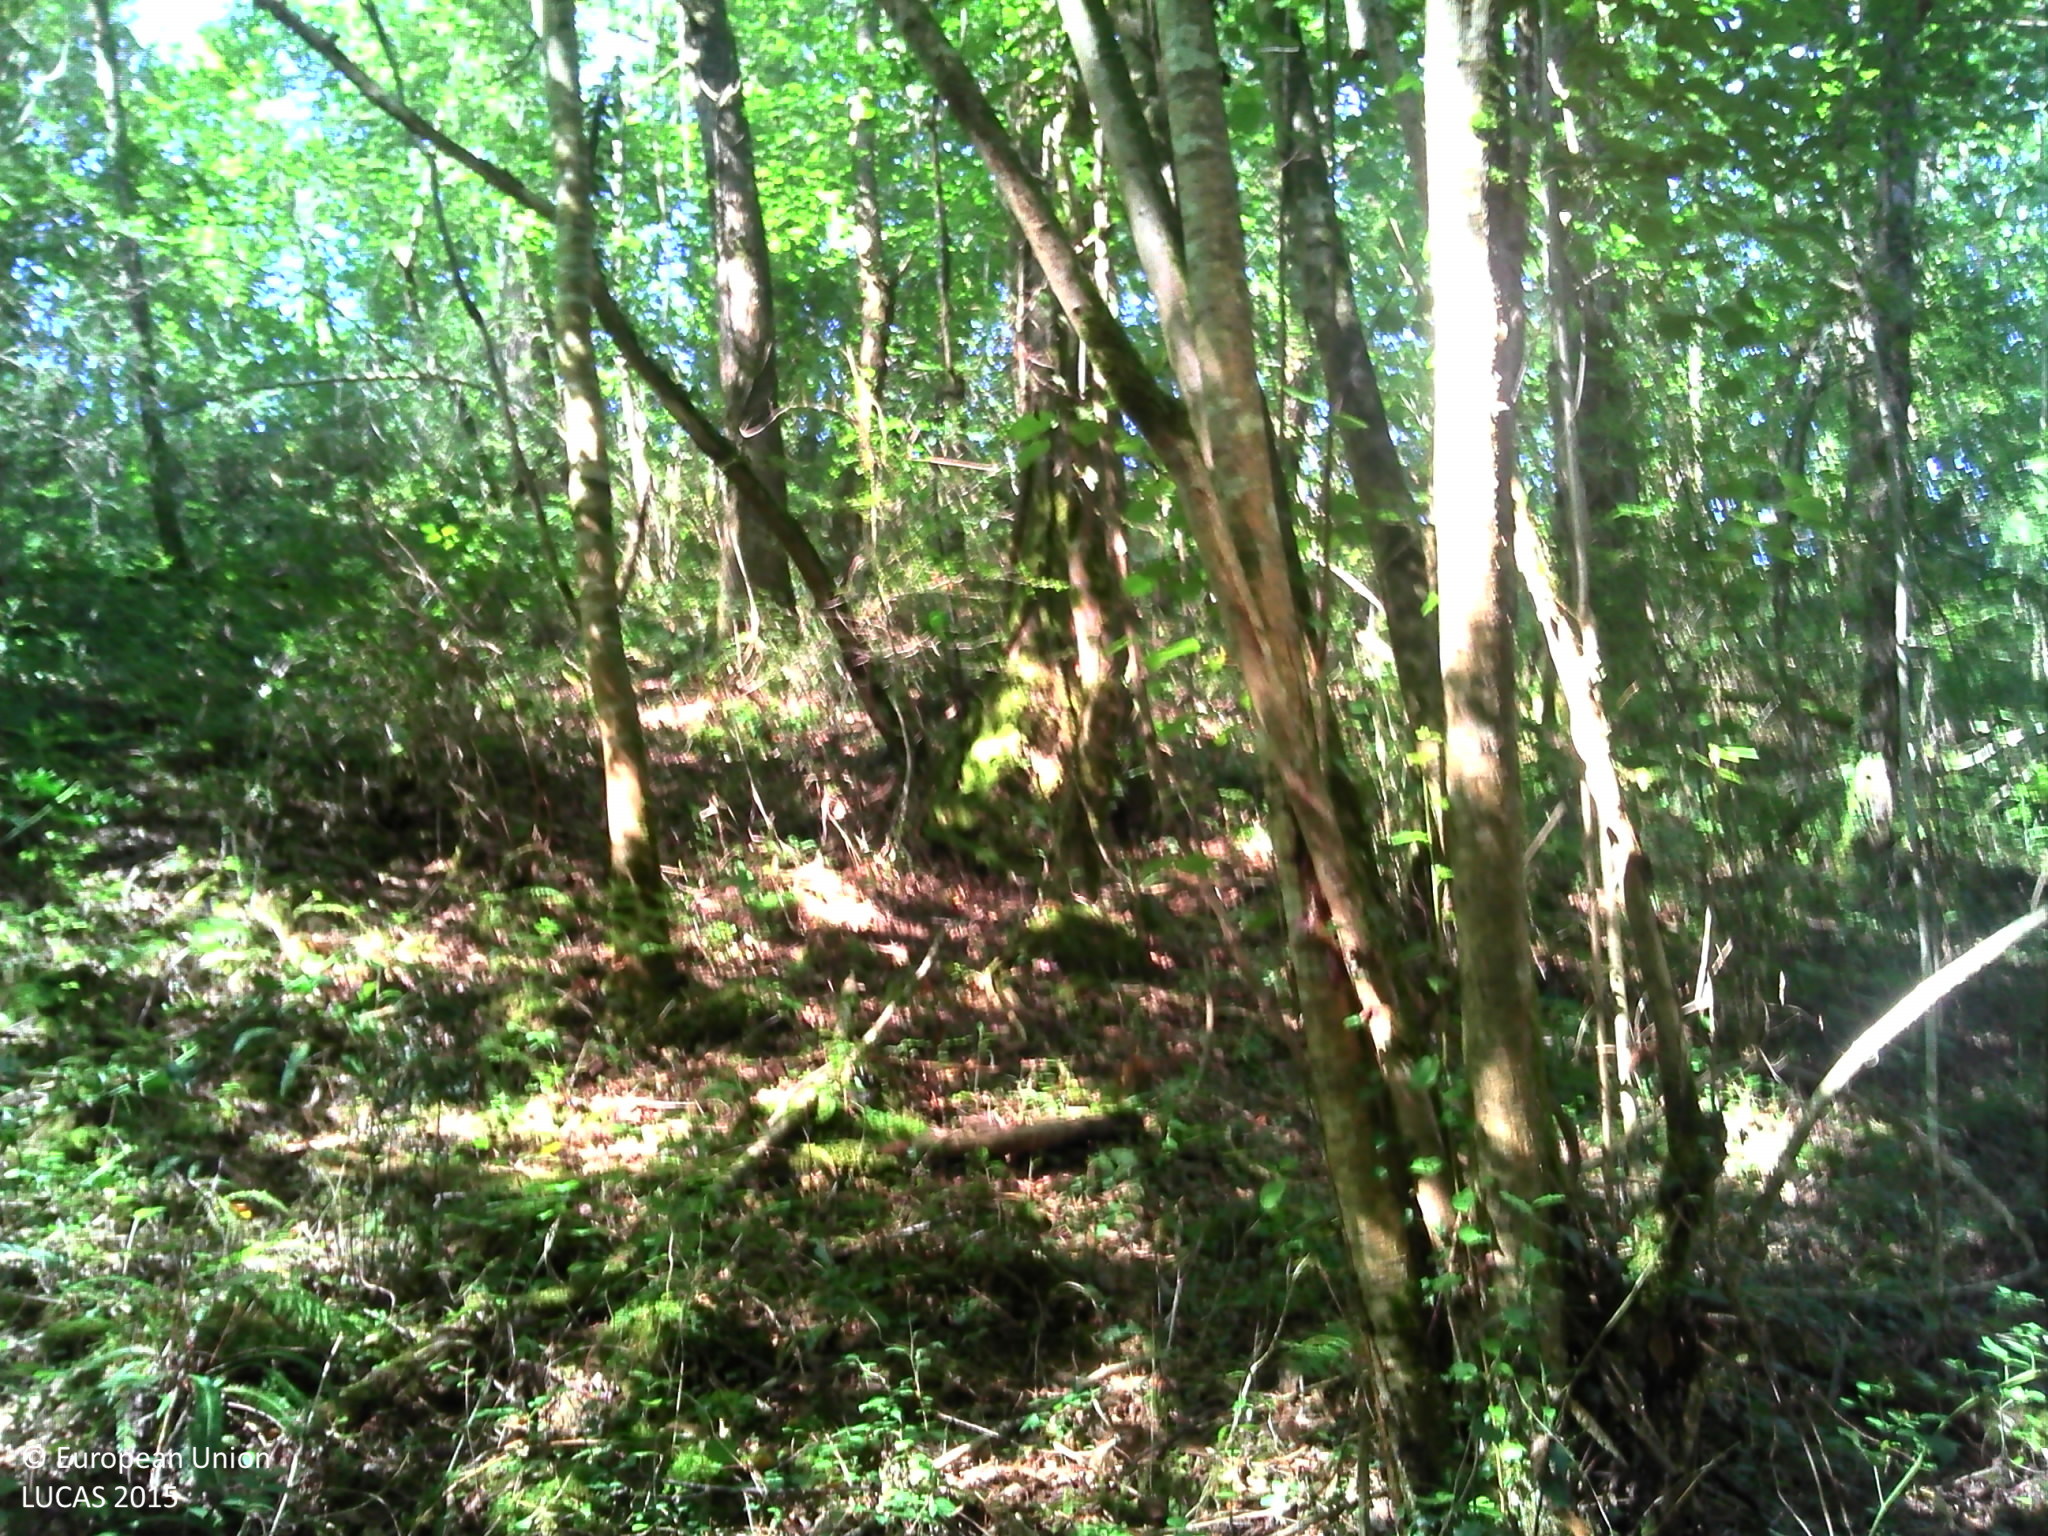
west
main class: Woodland
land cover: Broadleaved woodland
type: mesophytic deciduous forest
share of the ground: 50 - 75 %
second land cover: Spontaneously vegetated surfaces
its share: 25 - 50 %
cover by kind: broadleaved forest trees 70 %, herbaceous plants 15 %, shrubs 10 %, lichens and mosses 5 %
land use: Agriculture (excluding fallow land and kitchen gardens)
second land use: Forestry
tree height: > 5 m
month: September
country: FR
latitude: 43.2837
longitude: -1.0669
